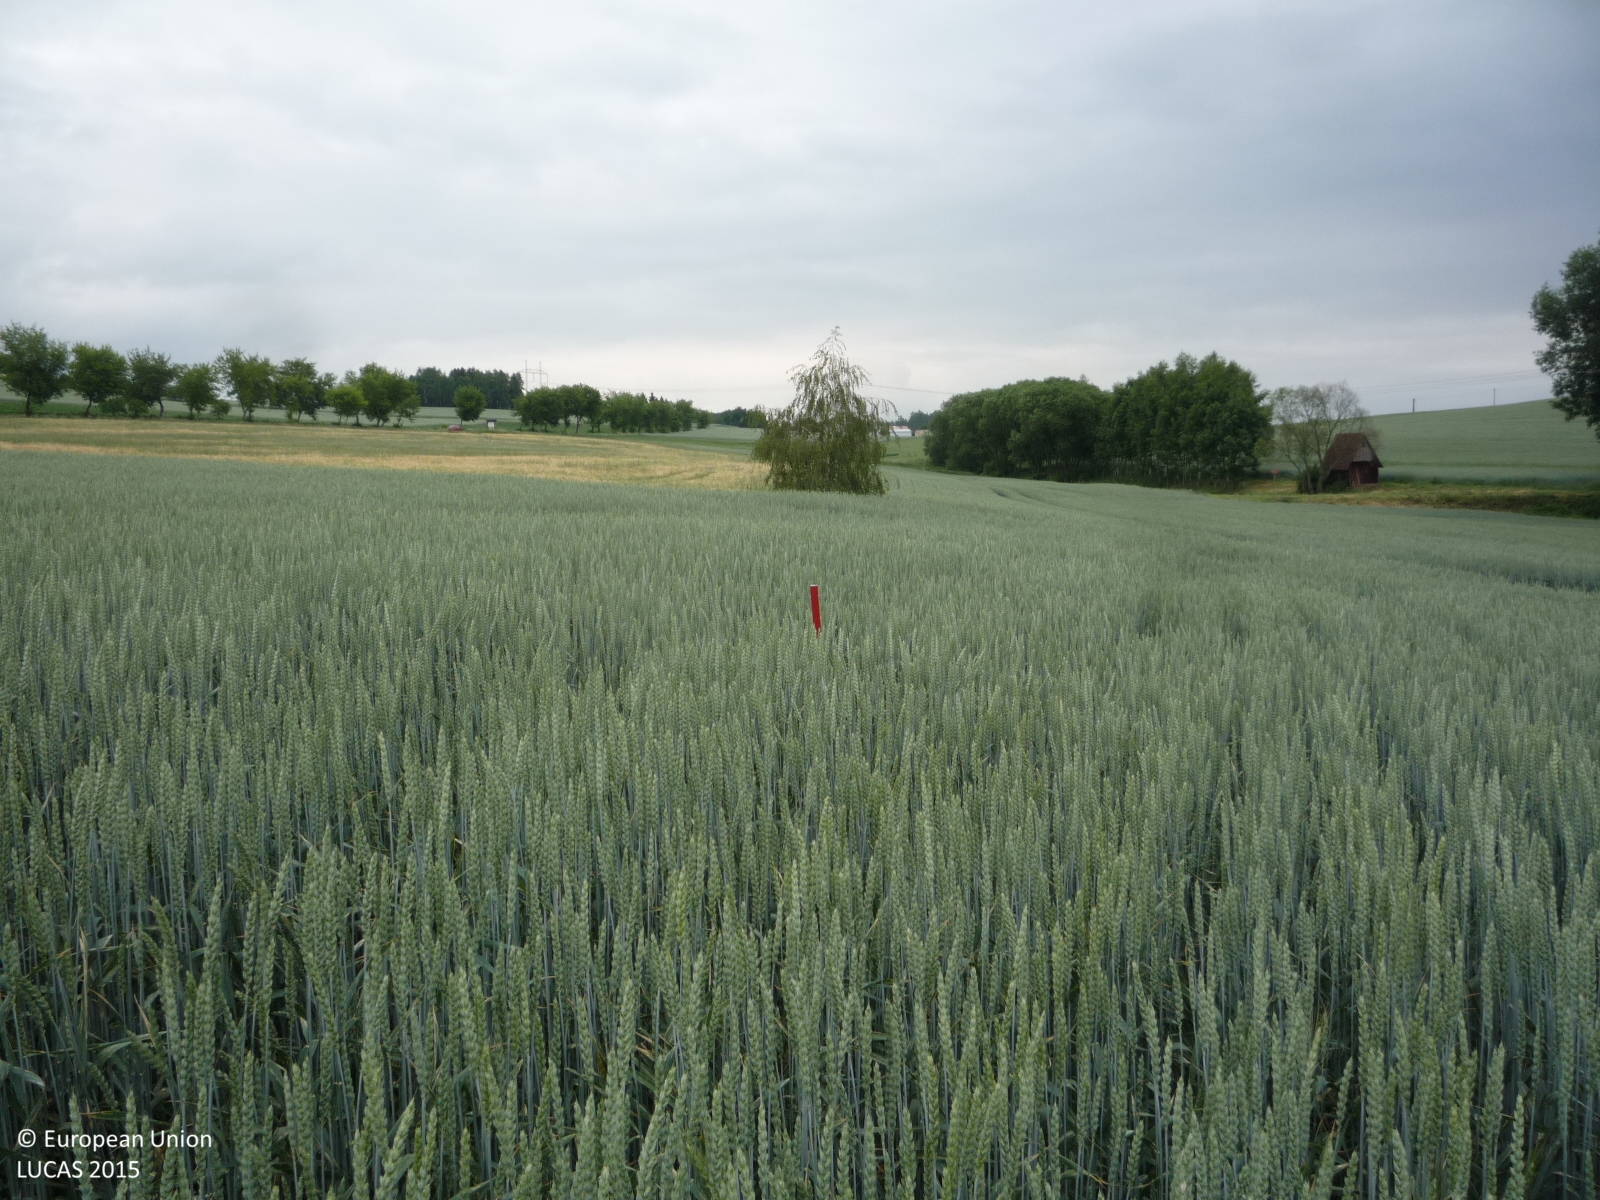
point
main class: Cropland
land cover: Common wheat
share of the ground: > 75 %
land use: Agriculture (excluding fallow land and kitchen gardens)
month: June
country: CZ
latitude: 49.8060
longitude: 14.9631
